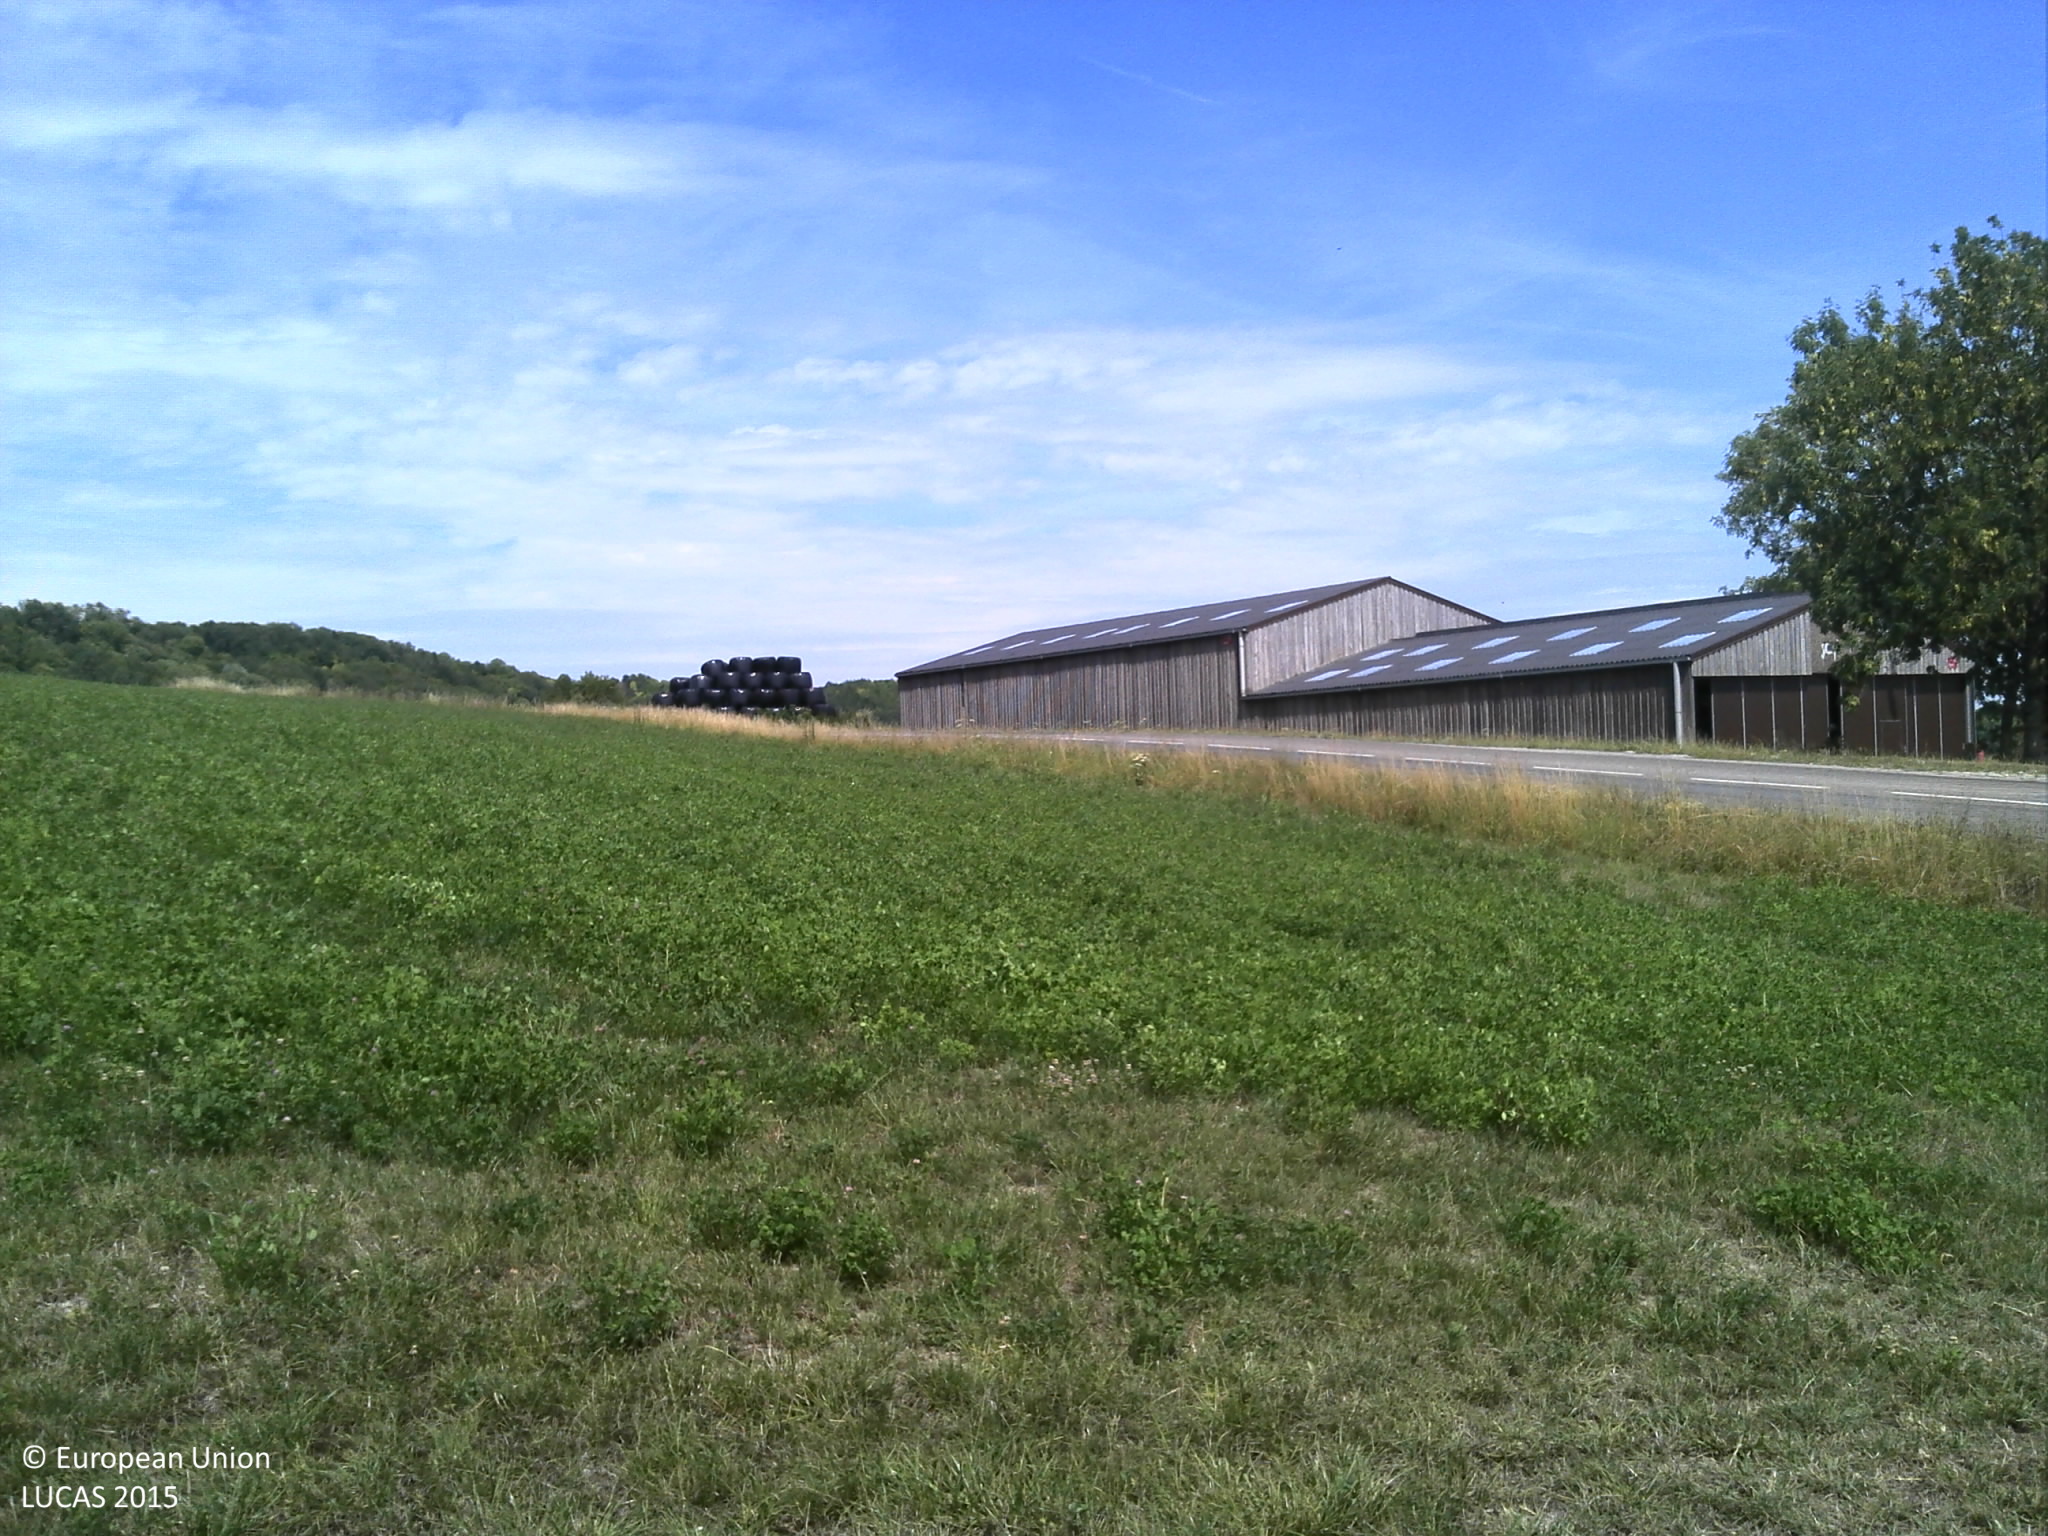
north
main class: Cropland
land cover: Clovers
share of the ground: > 75 %
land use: Agriculture (excluding fallow land and kitchen gardens)
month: July
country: FR
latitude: 49.6604
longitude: 4.2462
